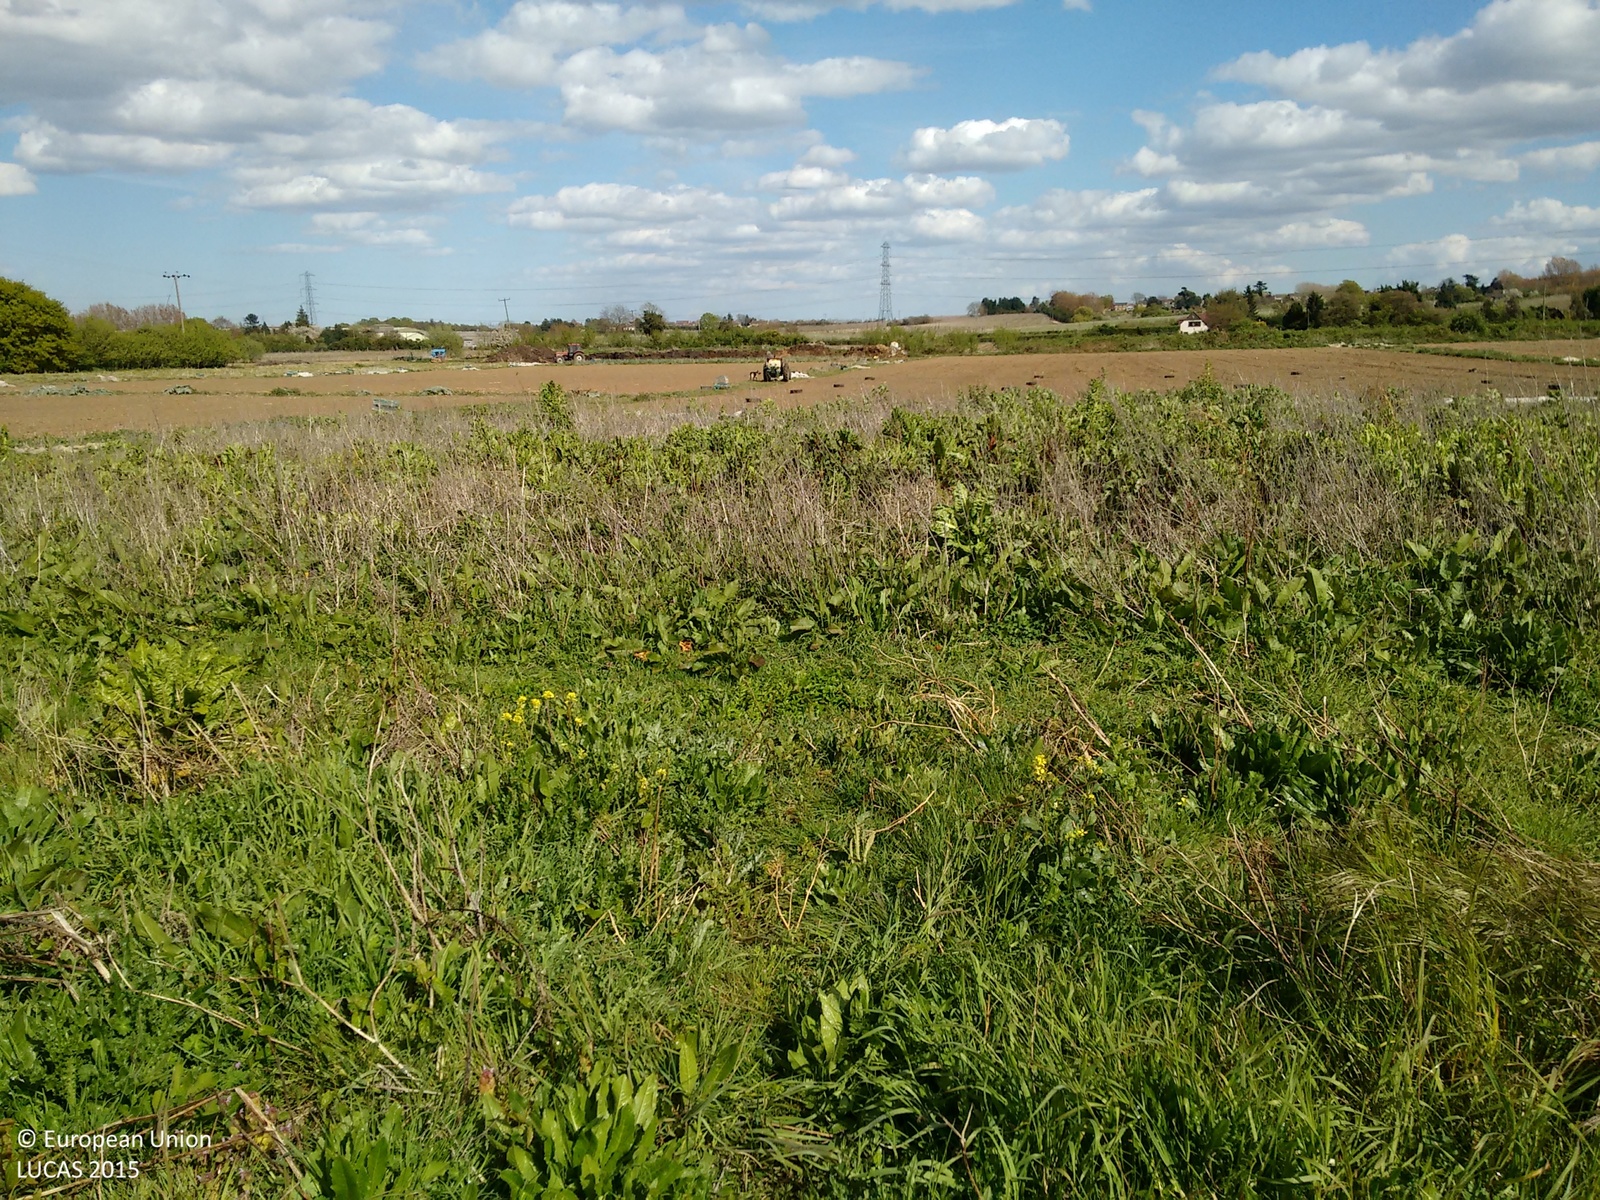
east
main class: Grassland
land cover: Grassland without tree/shrub cover
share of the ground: > 75 %
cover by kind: herbaceous plants 100 %
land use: Residential
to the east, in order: Grassland without tree/shrub cover; Fences; Managed hedges; Tracks; Grassland without tree/shrub cover; Other bare soil; Grass margins; Tracks; Grass margins; Other bare soil; Other fresh vegetables; Other bare soil; Abandoned hedges; Fences; Nurseries
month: April
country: GB
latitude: 51.3541
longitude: 0.6252
